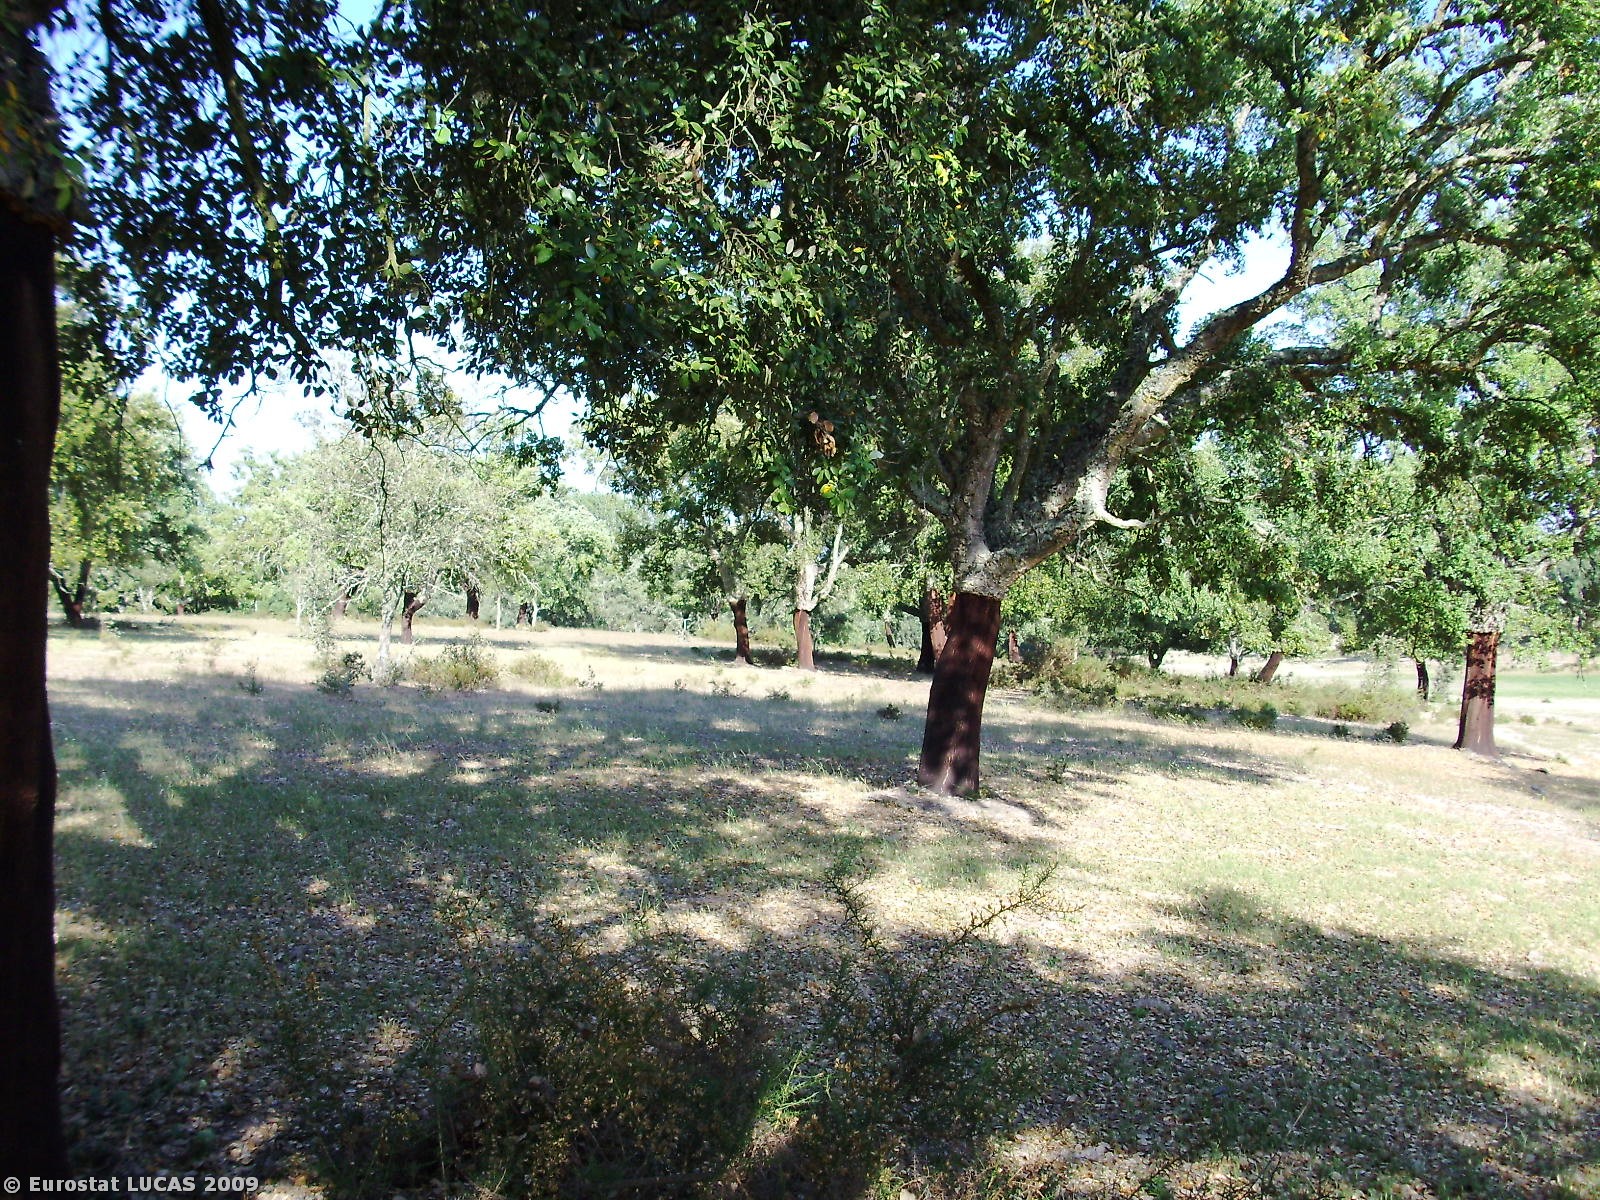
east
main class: Woodland
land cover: Broadleaved woodland
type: broadleaved evergreen forest
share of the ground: 50 - 75 %
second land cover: Grassland with sparse tree/shrub cover
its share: 25 - 50 %
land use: Forestry
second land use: Agriculture (excluding fallow land and kitchen gardens)
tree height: > 5 m
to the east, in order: Broadleaved woodland; Grassland with sparse tree/shrub cover; Broadleaved woodland; Fences; Lines of trees; Rivers and streams; Grassland without tree/shrub cover
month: May
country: PT
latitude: 39.0324
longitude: -7.9905
